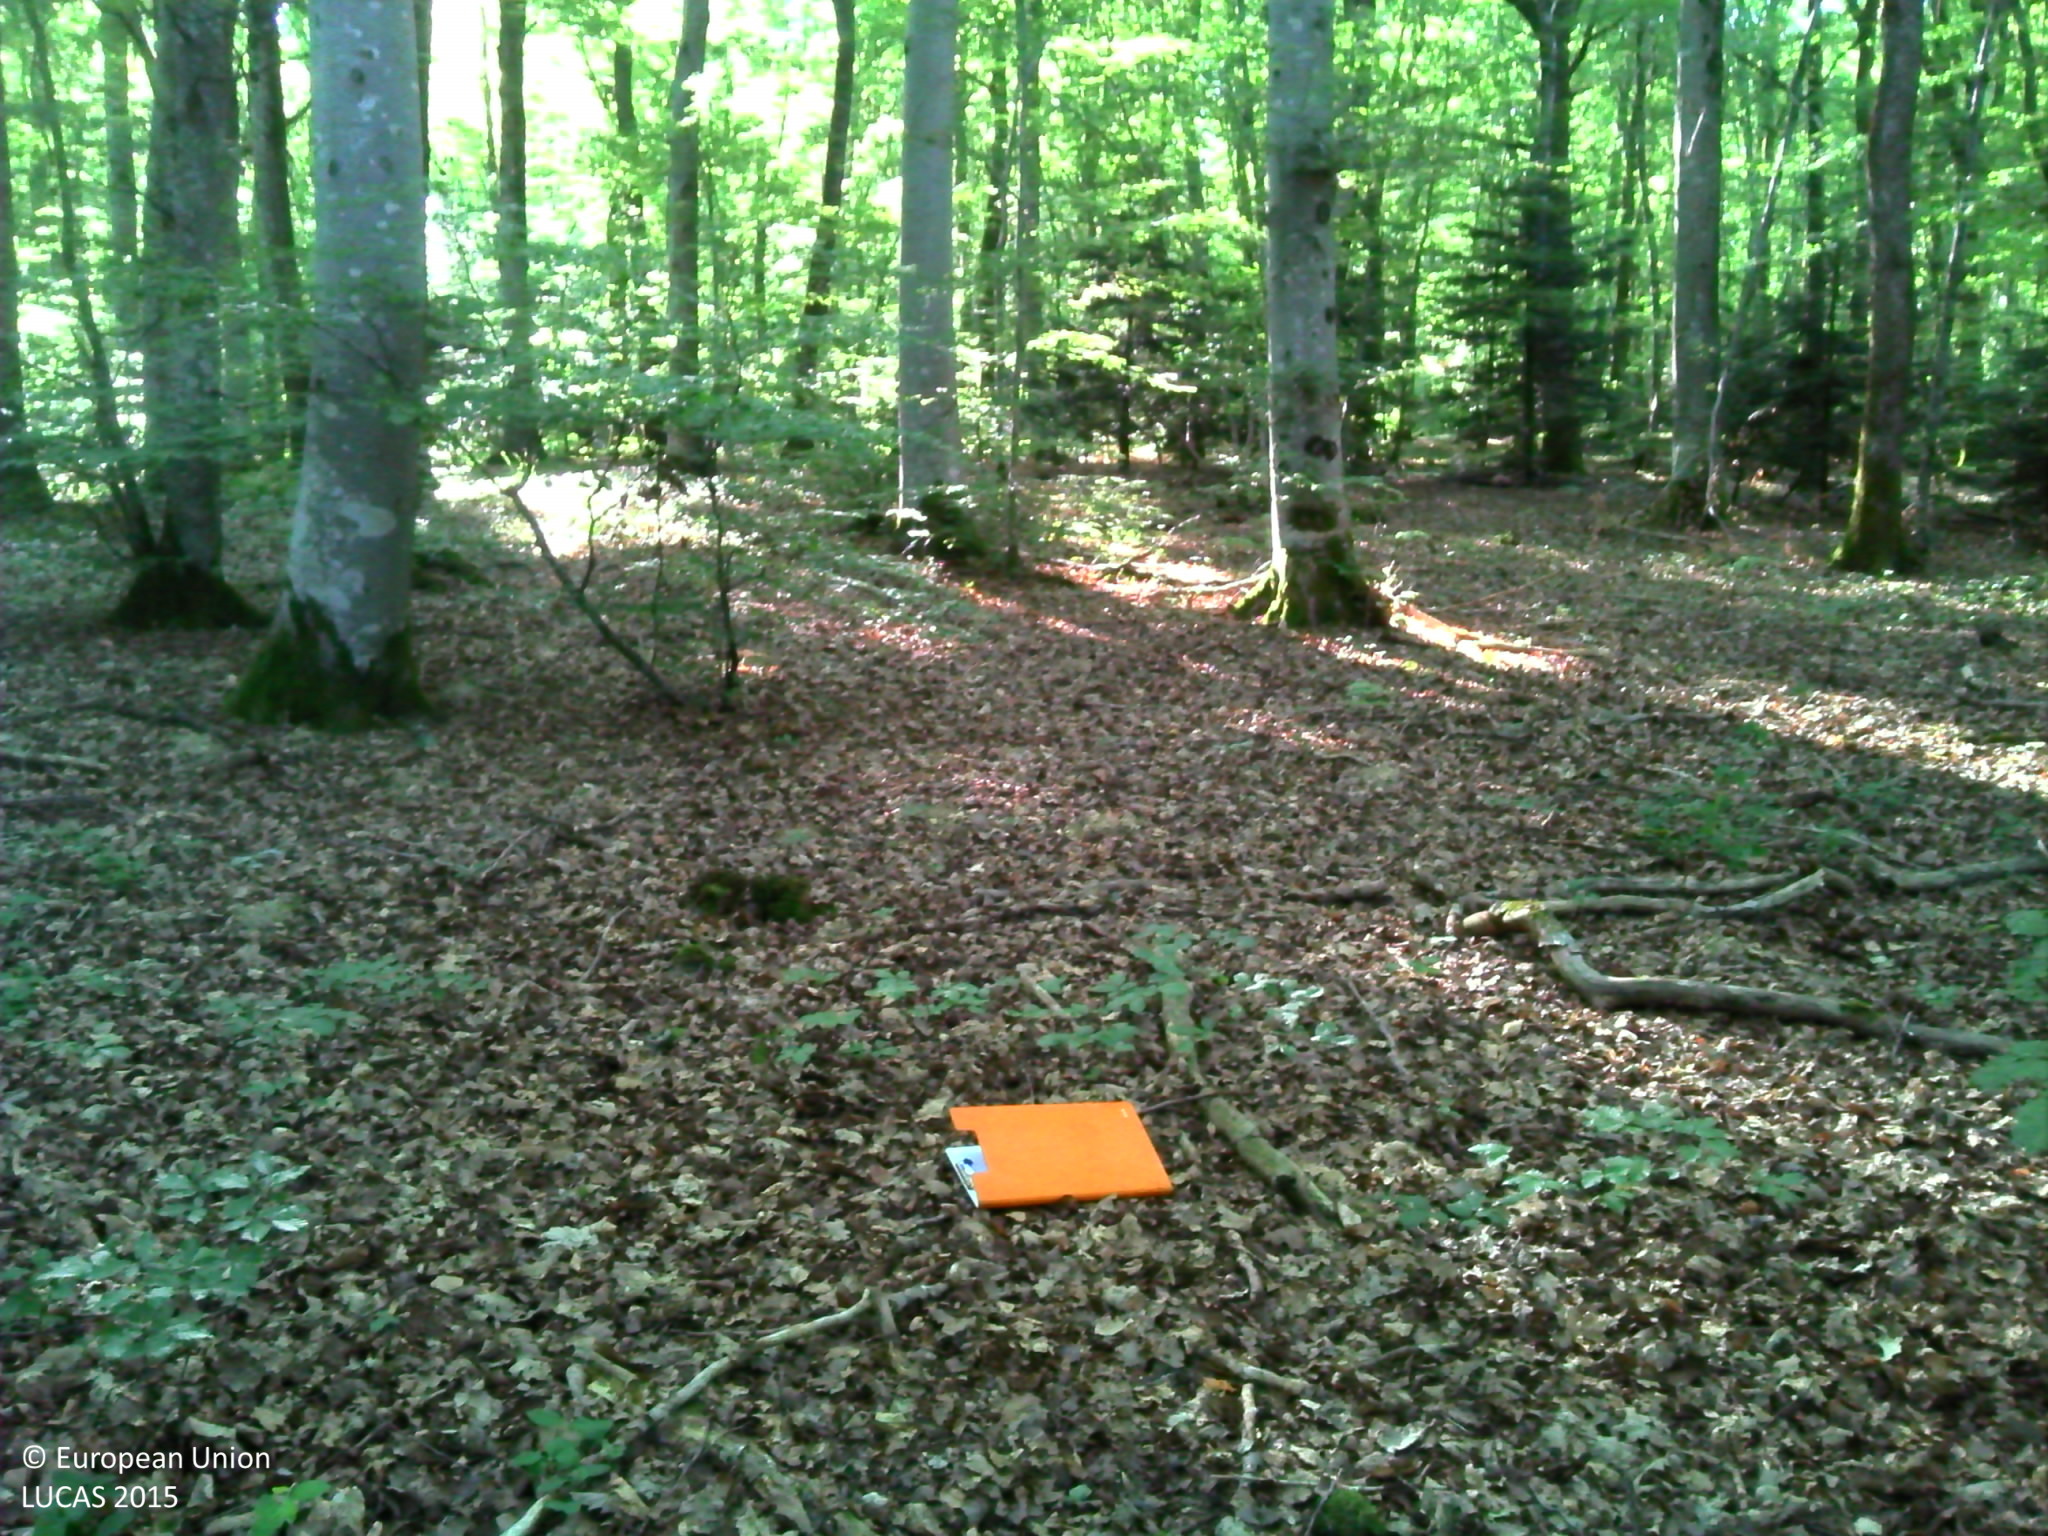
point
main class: Woodland
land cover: Broadleaved woodland
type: beech forest
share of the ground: > 75 %
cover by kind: broadleaved forest trees 90 %, coniferous forest trees 10 %
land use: Forestry
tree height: > 5 m
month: June
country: FR
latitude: 47.5224
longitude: 6.0569
